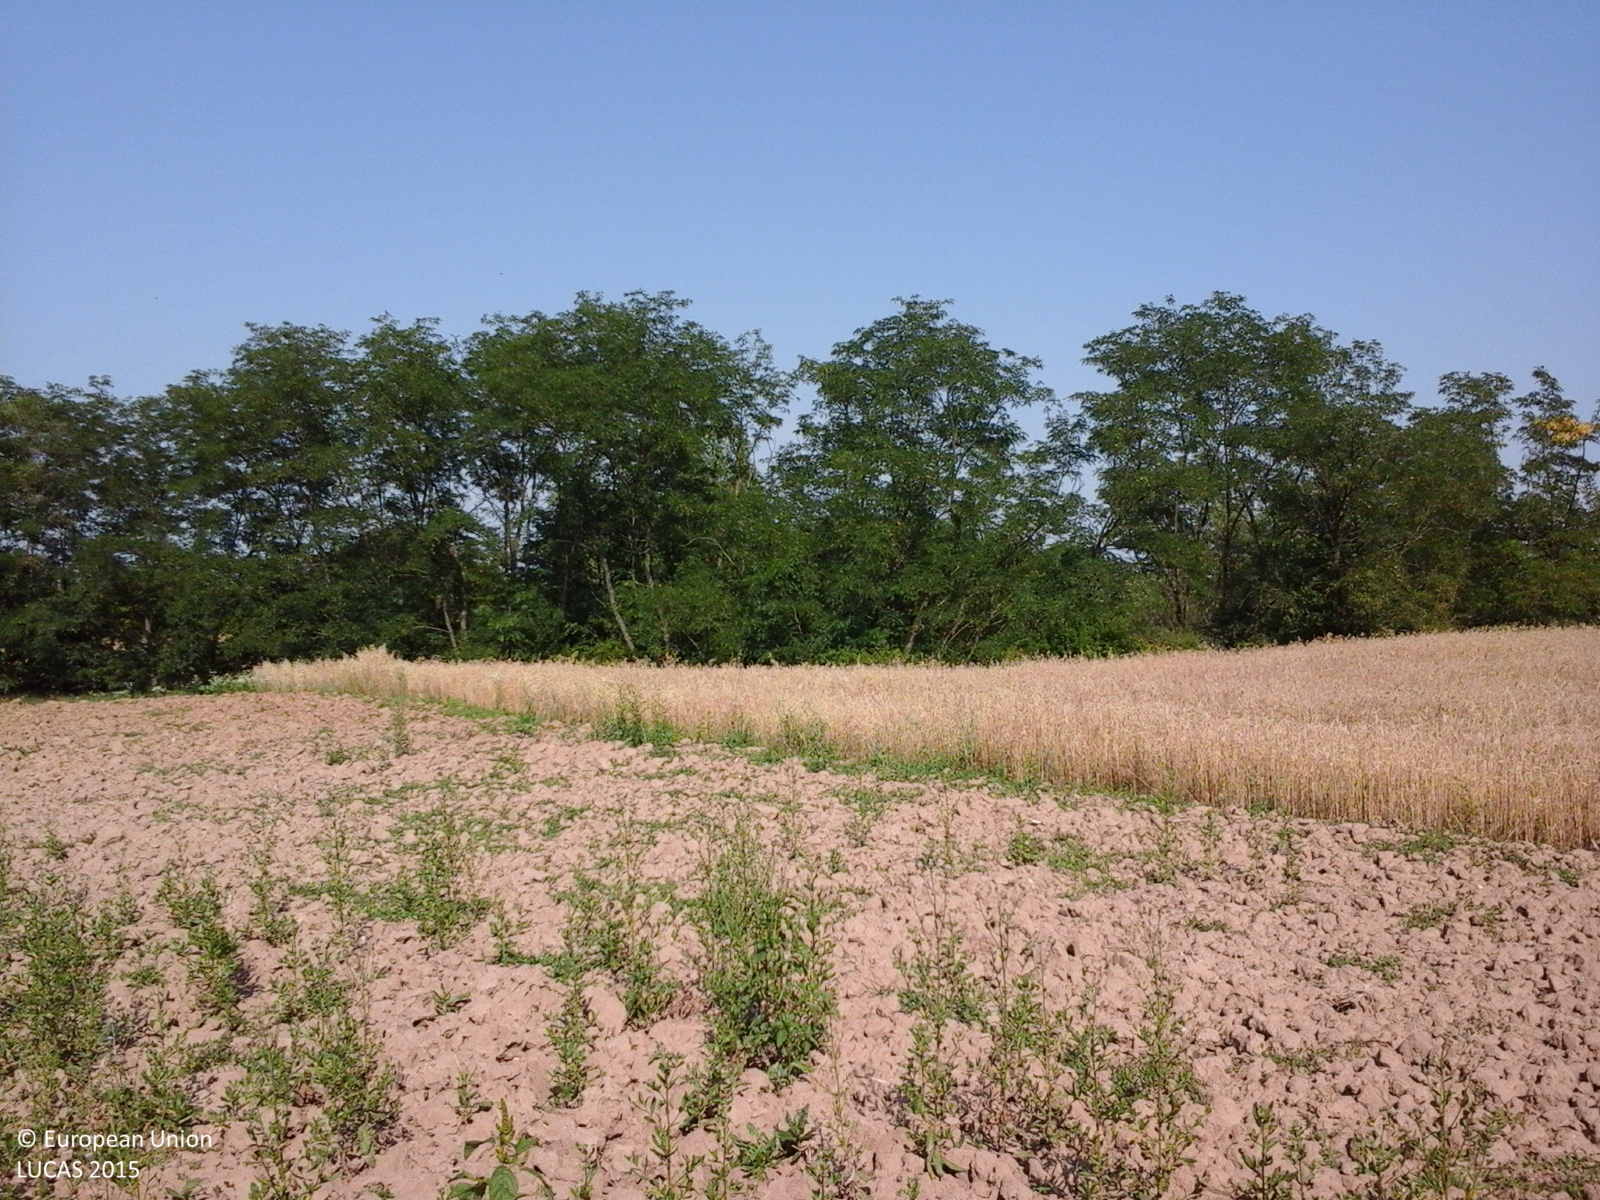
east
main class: Grassland
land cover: Spontaneously vegetated surfaces
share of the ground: 10 - 25 %
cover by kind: unconsolidated bare surface 85 %, herbaceous plants 15 %
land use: Agriculture (excluding fallow land and kitchen gardens)
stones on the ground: < 10 %
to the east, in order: Spontaneously vegetated surfaces; Common wheat; Abandoned hedges; Inland fresh running water; Abandoned hedges; Grass margins; Tracks; Grass margins; Maize; Grassland without tree/shrub cover; Artificial constructions in urban areas
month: July
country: RO
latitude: 44.6952
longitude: 24.6509
